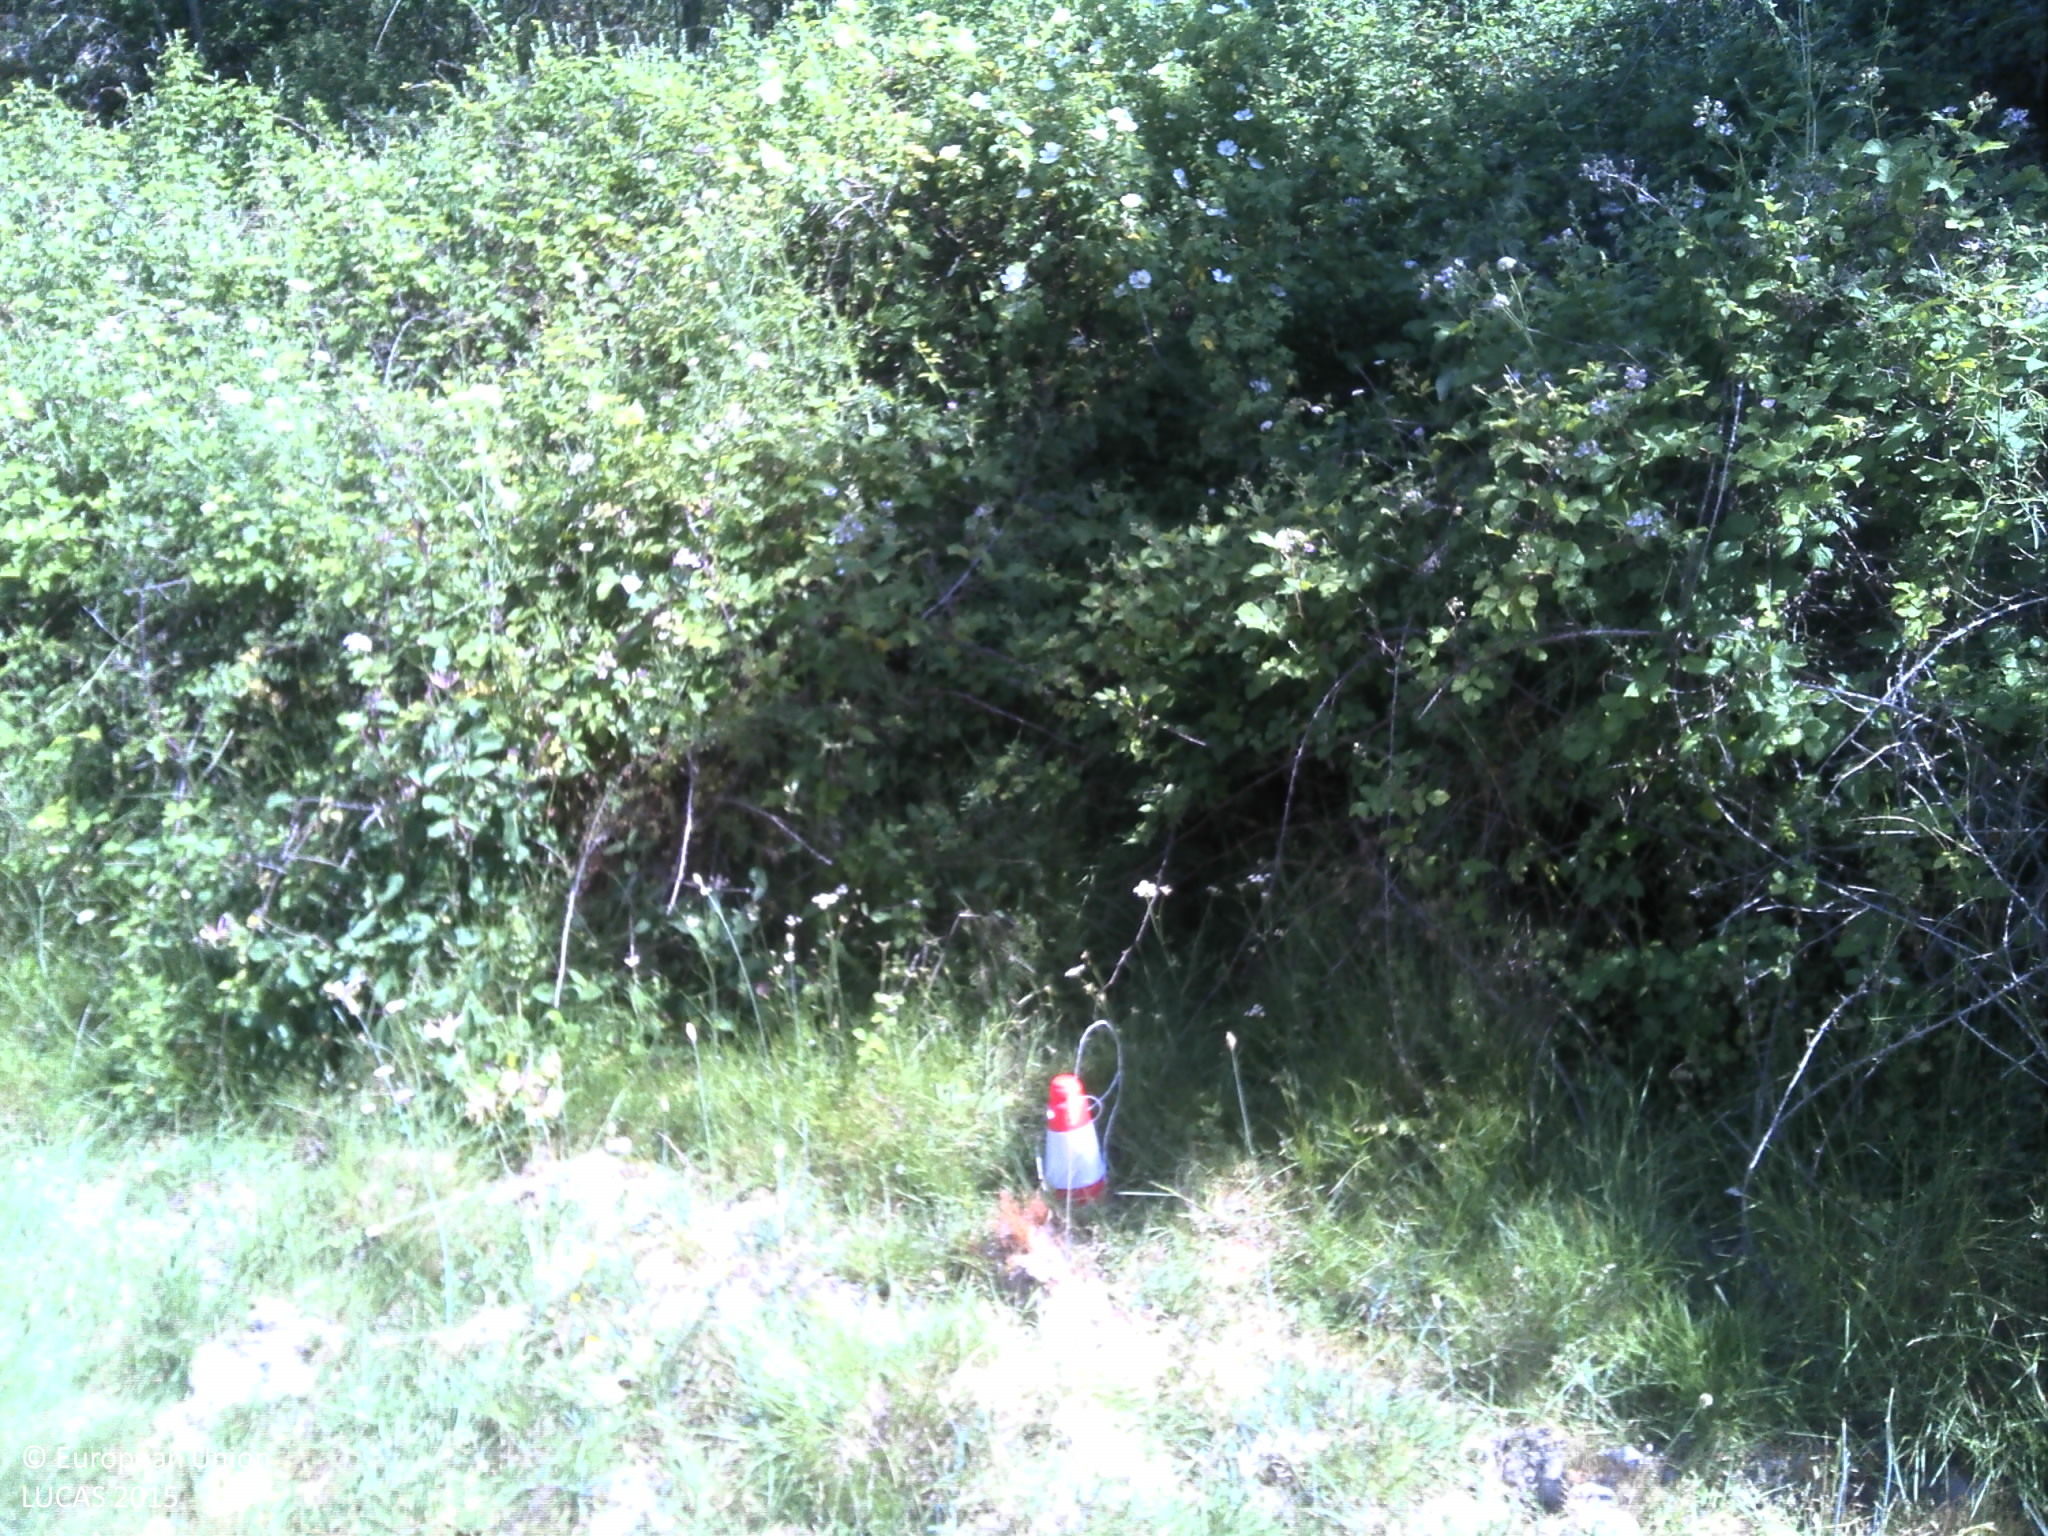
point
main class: Grassland
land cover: Grassland without tree/shrub cover
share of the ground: 50 - 75 %
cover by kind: herbaceous plants 90 %, unconsolidated bare surface 5 %
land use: Agriculture (excluding fallow land and kitchen gardens)
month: June
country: PT
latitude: 40.6893
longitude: -6.8905
